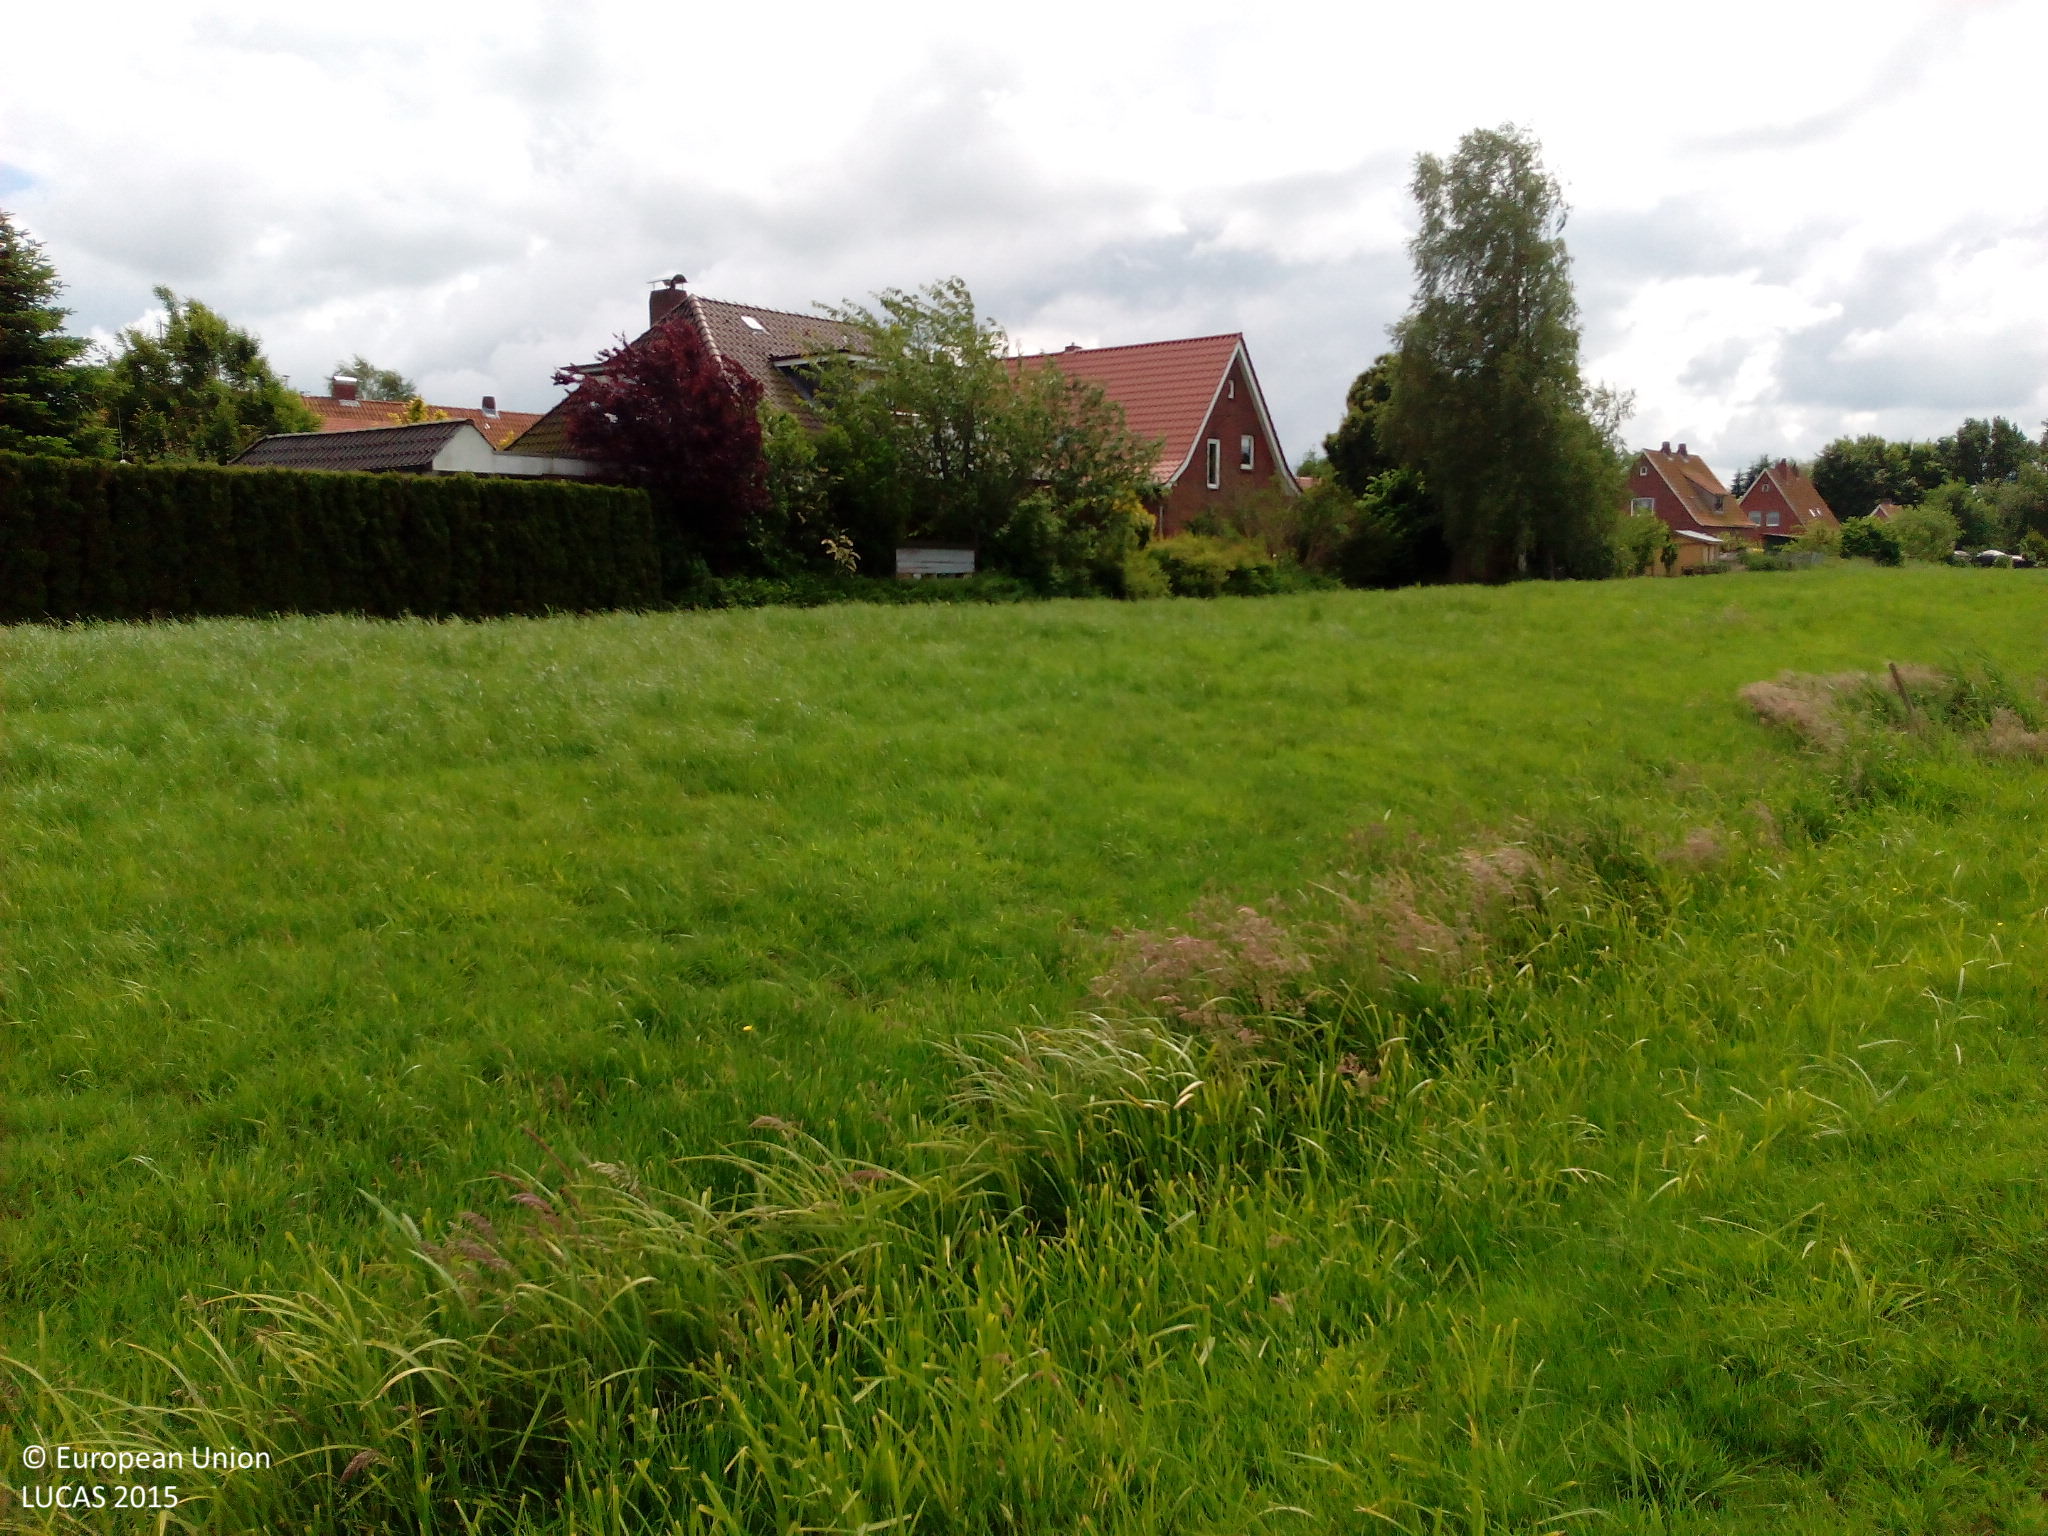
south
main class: Grassland
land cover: Grassland without tree/shrub cover
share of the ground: > 75 %
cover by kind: herbaceous plants 100 %
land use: Agriculture (excluding fallow land and kitchen gardens)
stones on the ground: < 10 %
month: June
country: DE
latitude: 53.7774
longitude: 9.3175
